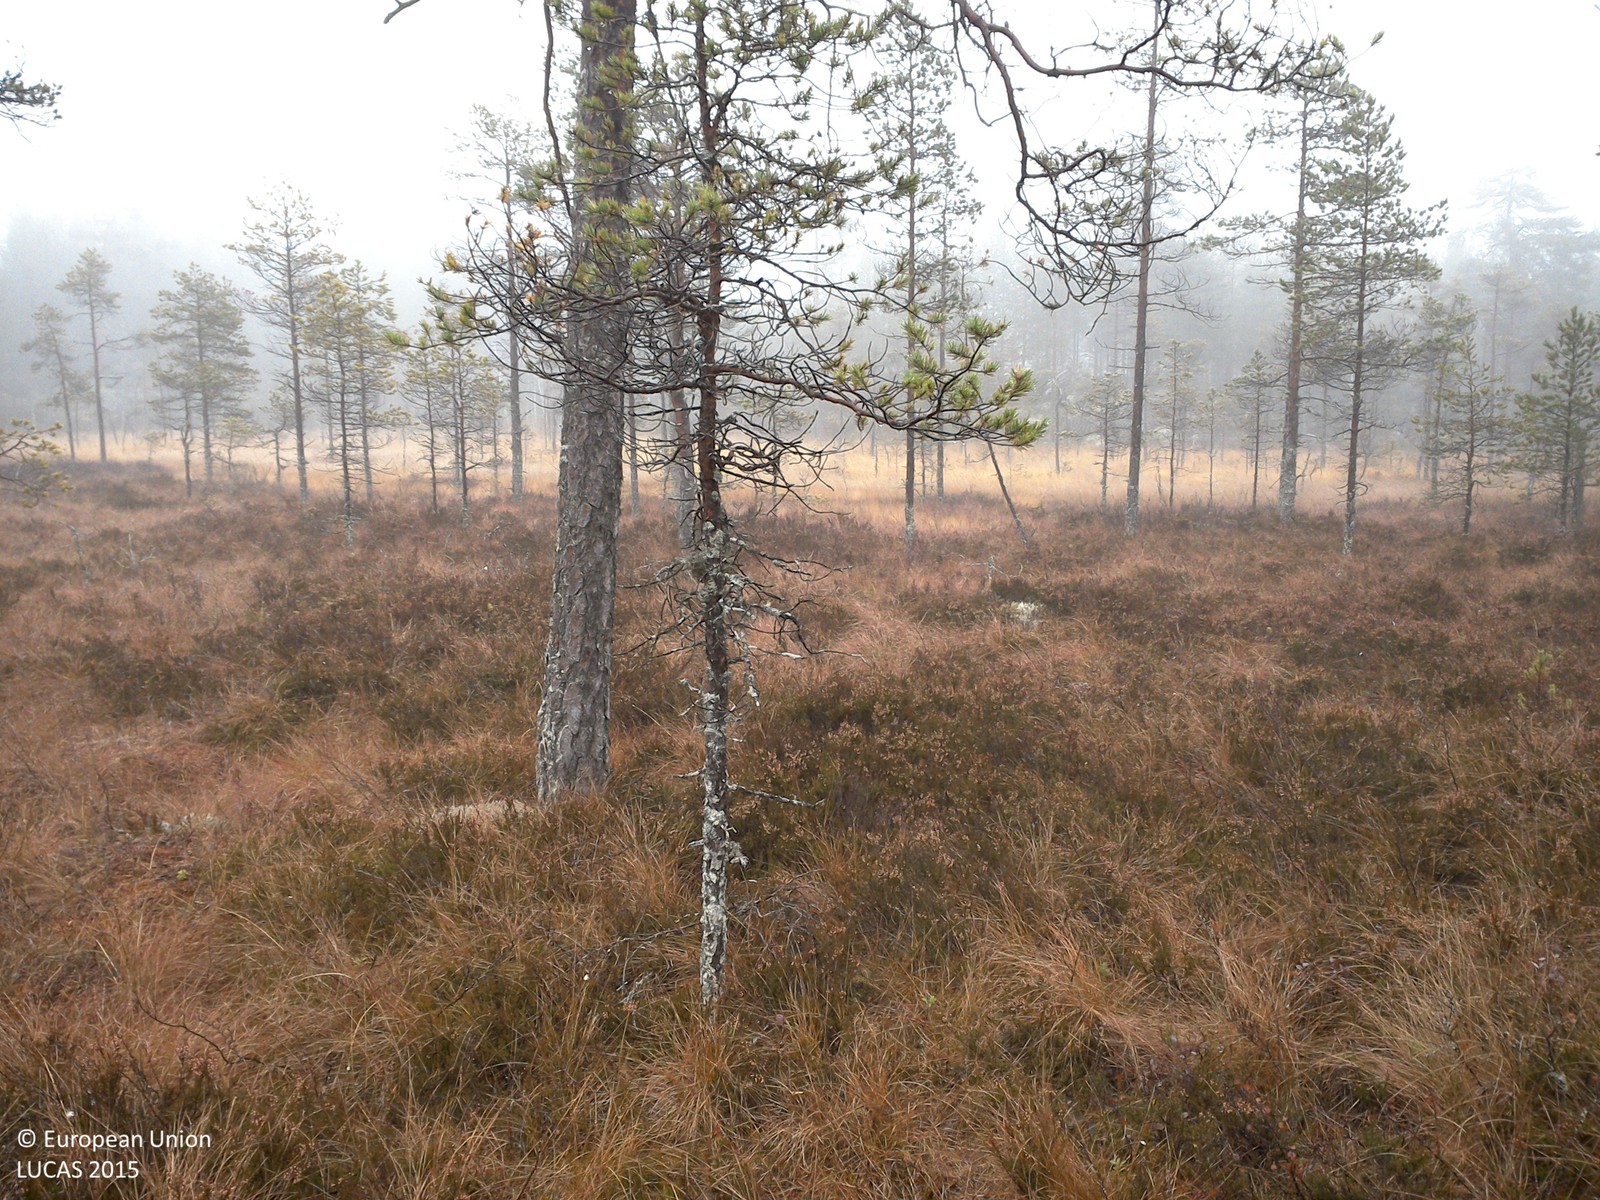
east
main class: Woodland
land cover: Pine dominated coniferous woodland
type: boreal forest
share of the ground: 25 - 50 %
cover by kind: coniferous forest trees 40 %, shrubs 30 %, herbaceous plants 15 %, lichens and mosses 15 %
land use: Forestry
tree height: > 5 m
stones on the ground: < 10 %
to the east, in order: Pine dominated coniferous woodland; Peatbogs; Pine dominated coniferous woodland; Rivers and streams; Shrubland with sparse tree cover; Pine dominated coniferous woodland
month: November
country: SE
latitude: 60.5901
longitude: 14.6796
